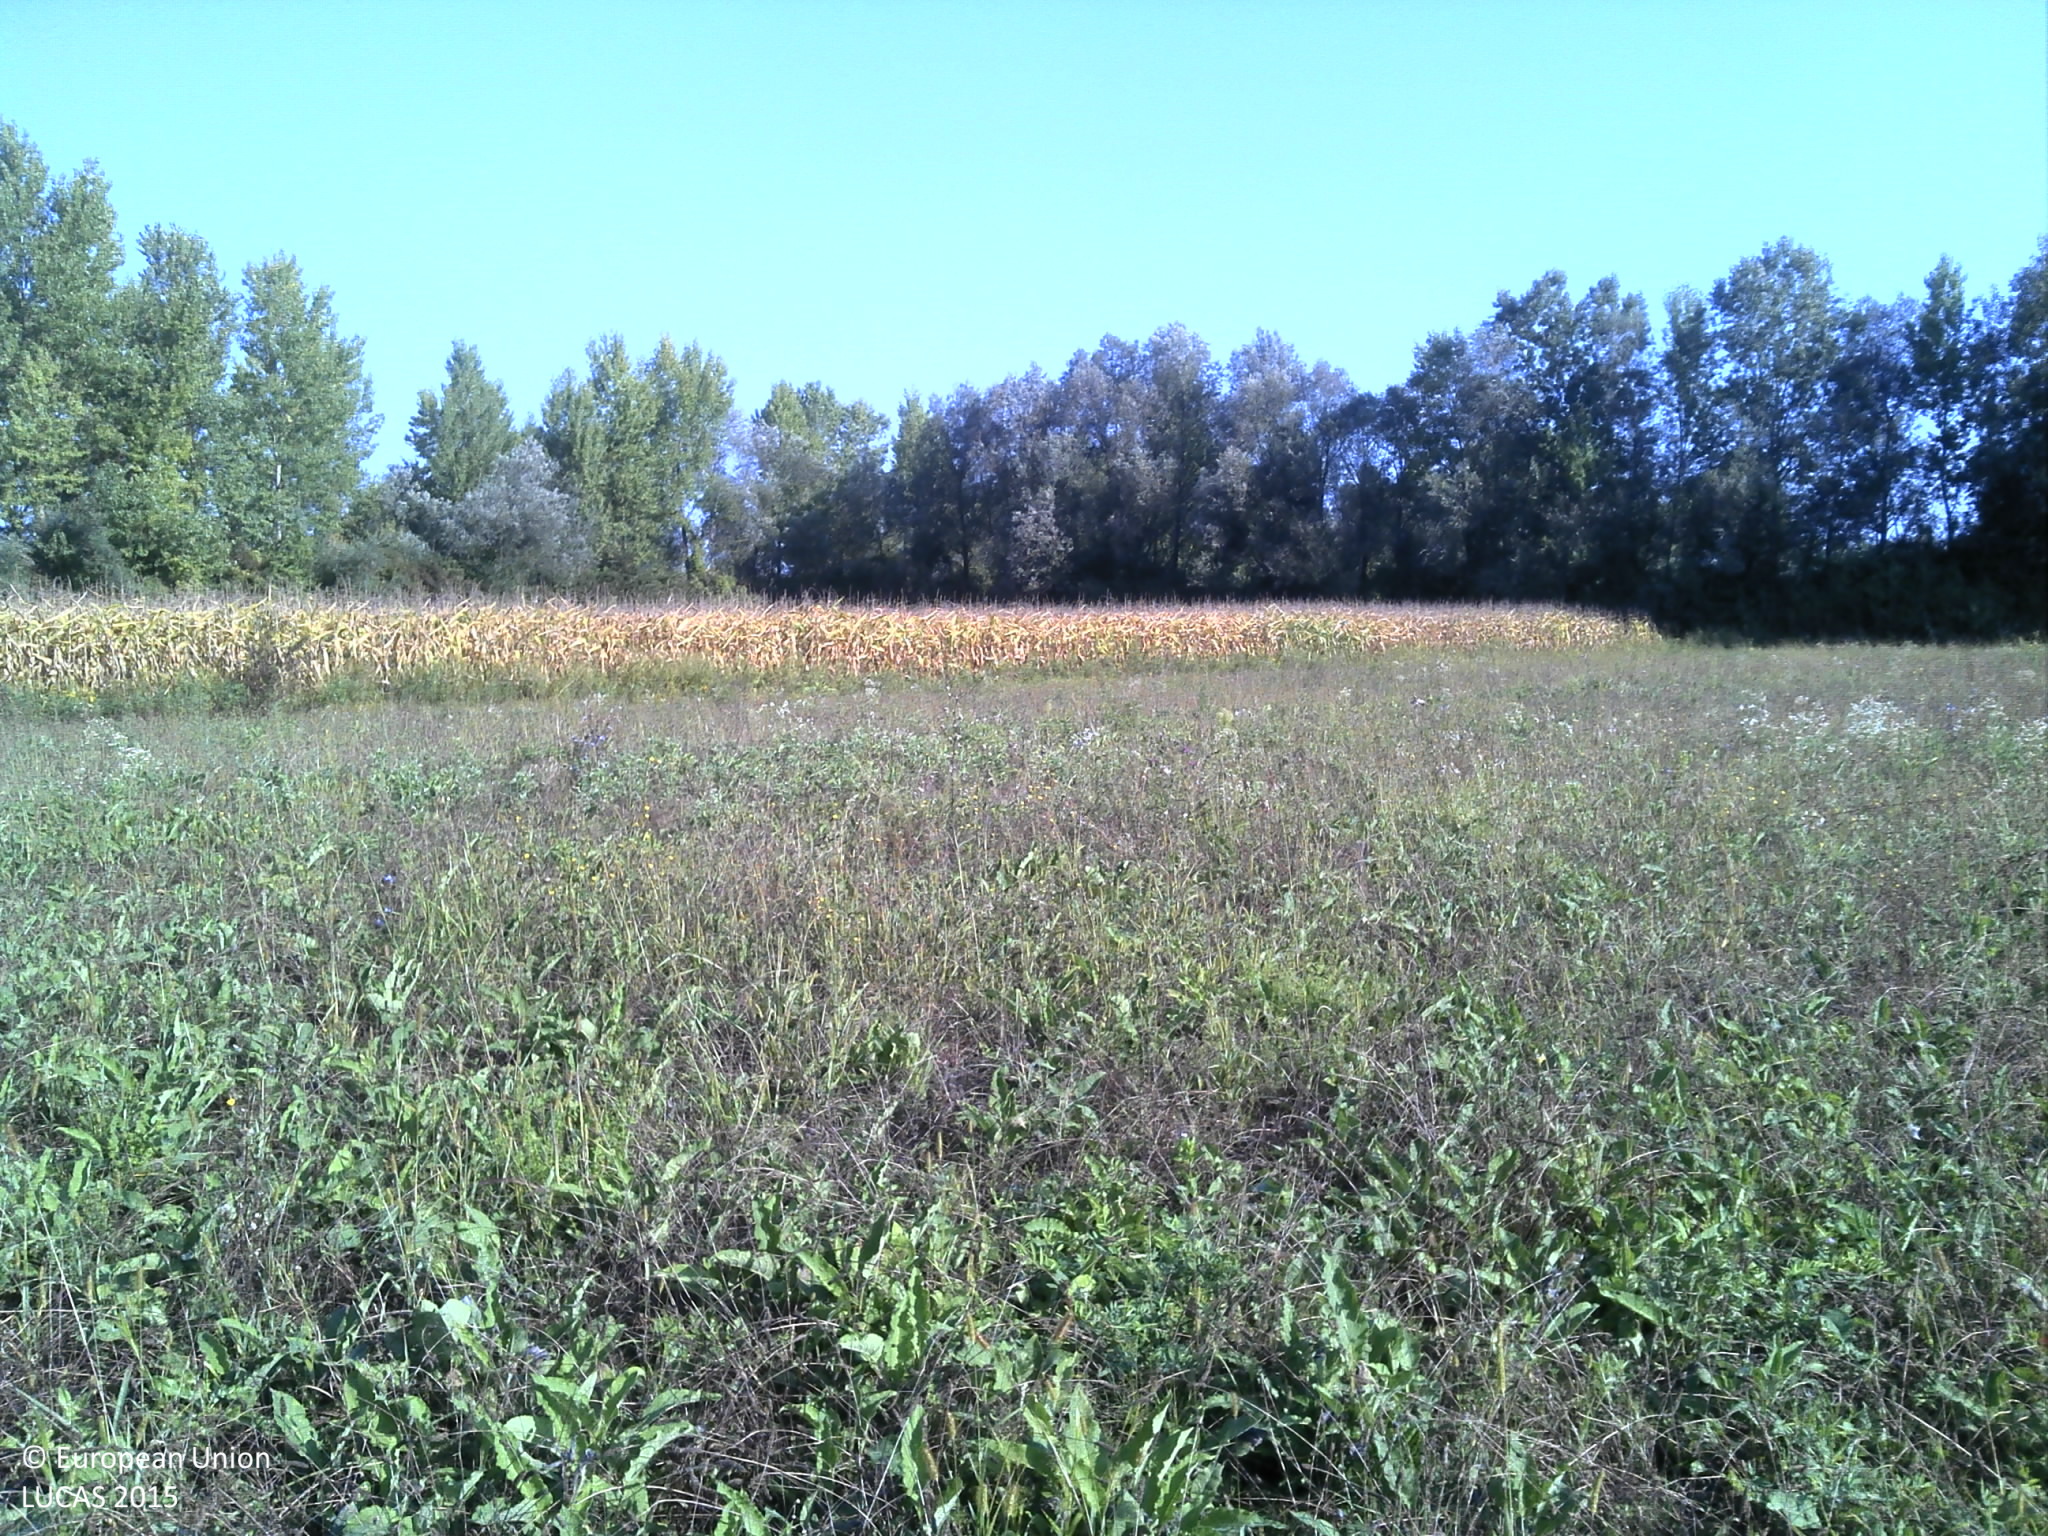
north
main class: Grassland
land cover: Grassland without tree/shrub cover
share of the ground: > 75 %
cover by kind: herbaceous plants 100 %
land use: Agriculture (excluding fallow land and kitchen gardens)
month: September
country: HR
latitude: 45.5817
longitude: 16.3935
